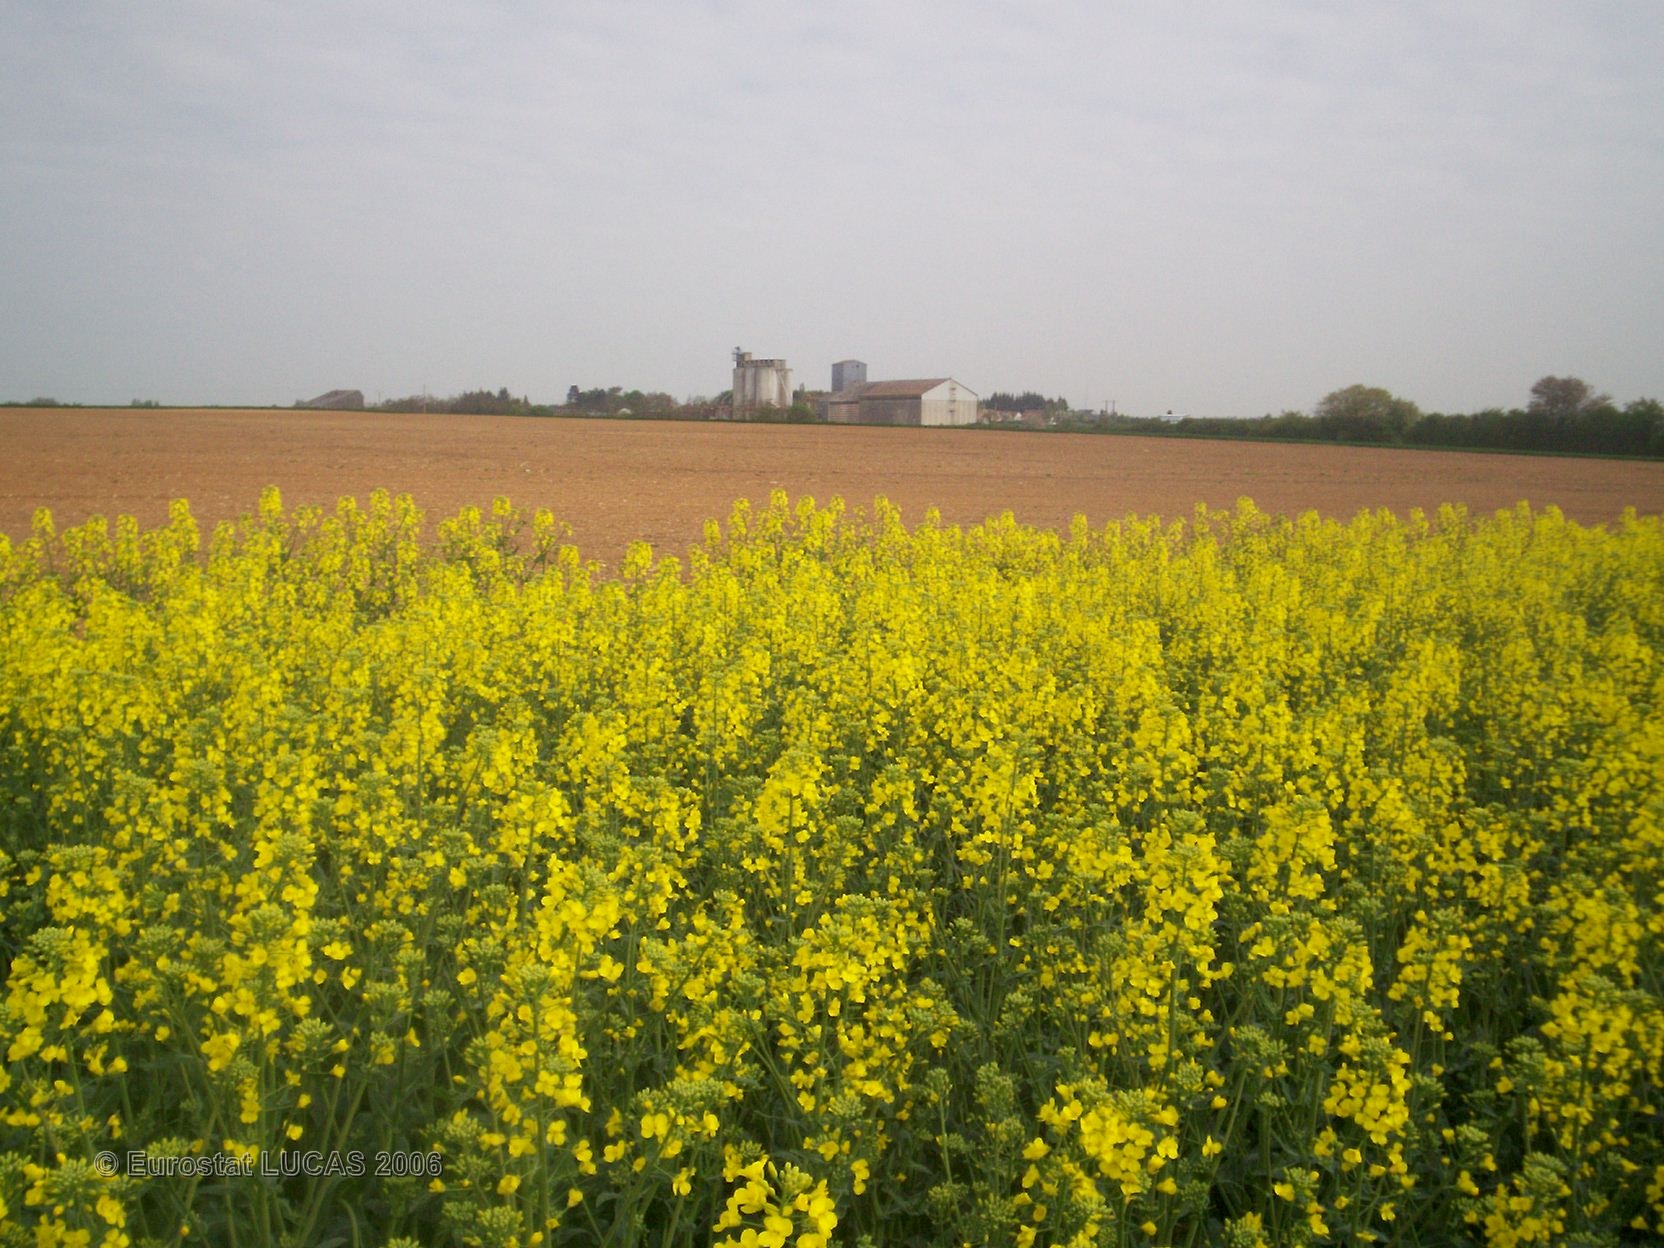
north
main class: Cropland
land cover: Rape and turnip rape
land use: Agriculture (excluding fallow land and kitchen gardens)
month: April
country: FR
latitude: 47.7439
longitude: 1.1941
